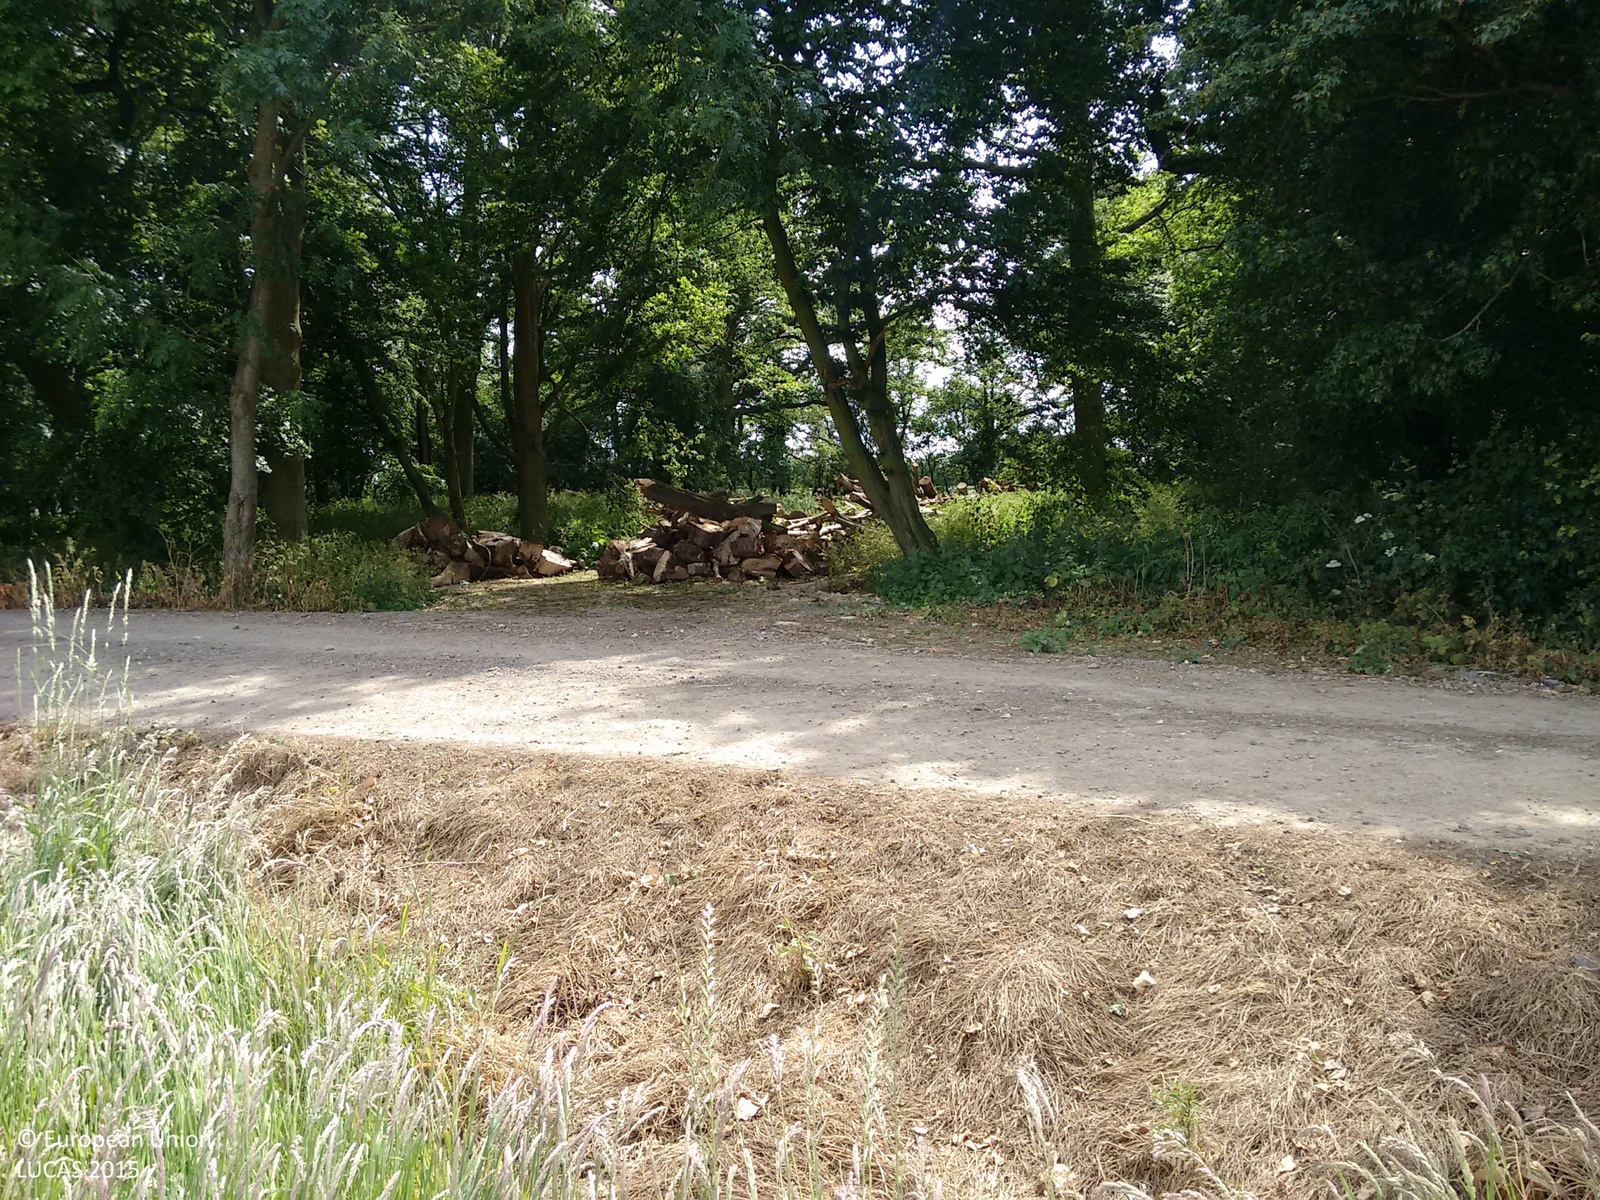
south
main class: Grassland
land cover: Grassland without tree/shrub cover
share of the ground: > 75 %
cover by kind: herbaceous plants 100 %
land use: Agriculture (excluding fallow land and kitchen gardens)
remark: Harvested field
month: June
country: GB
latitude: 51.8447
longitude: -1.2096
